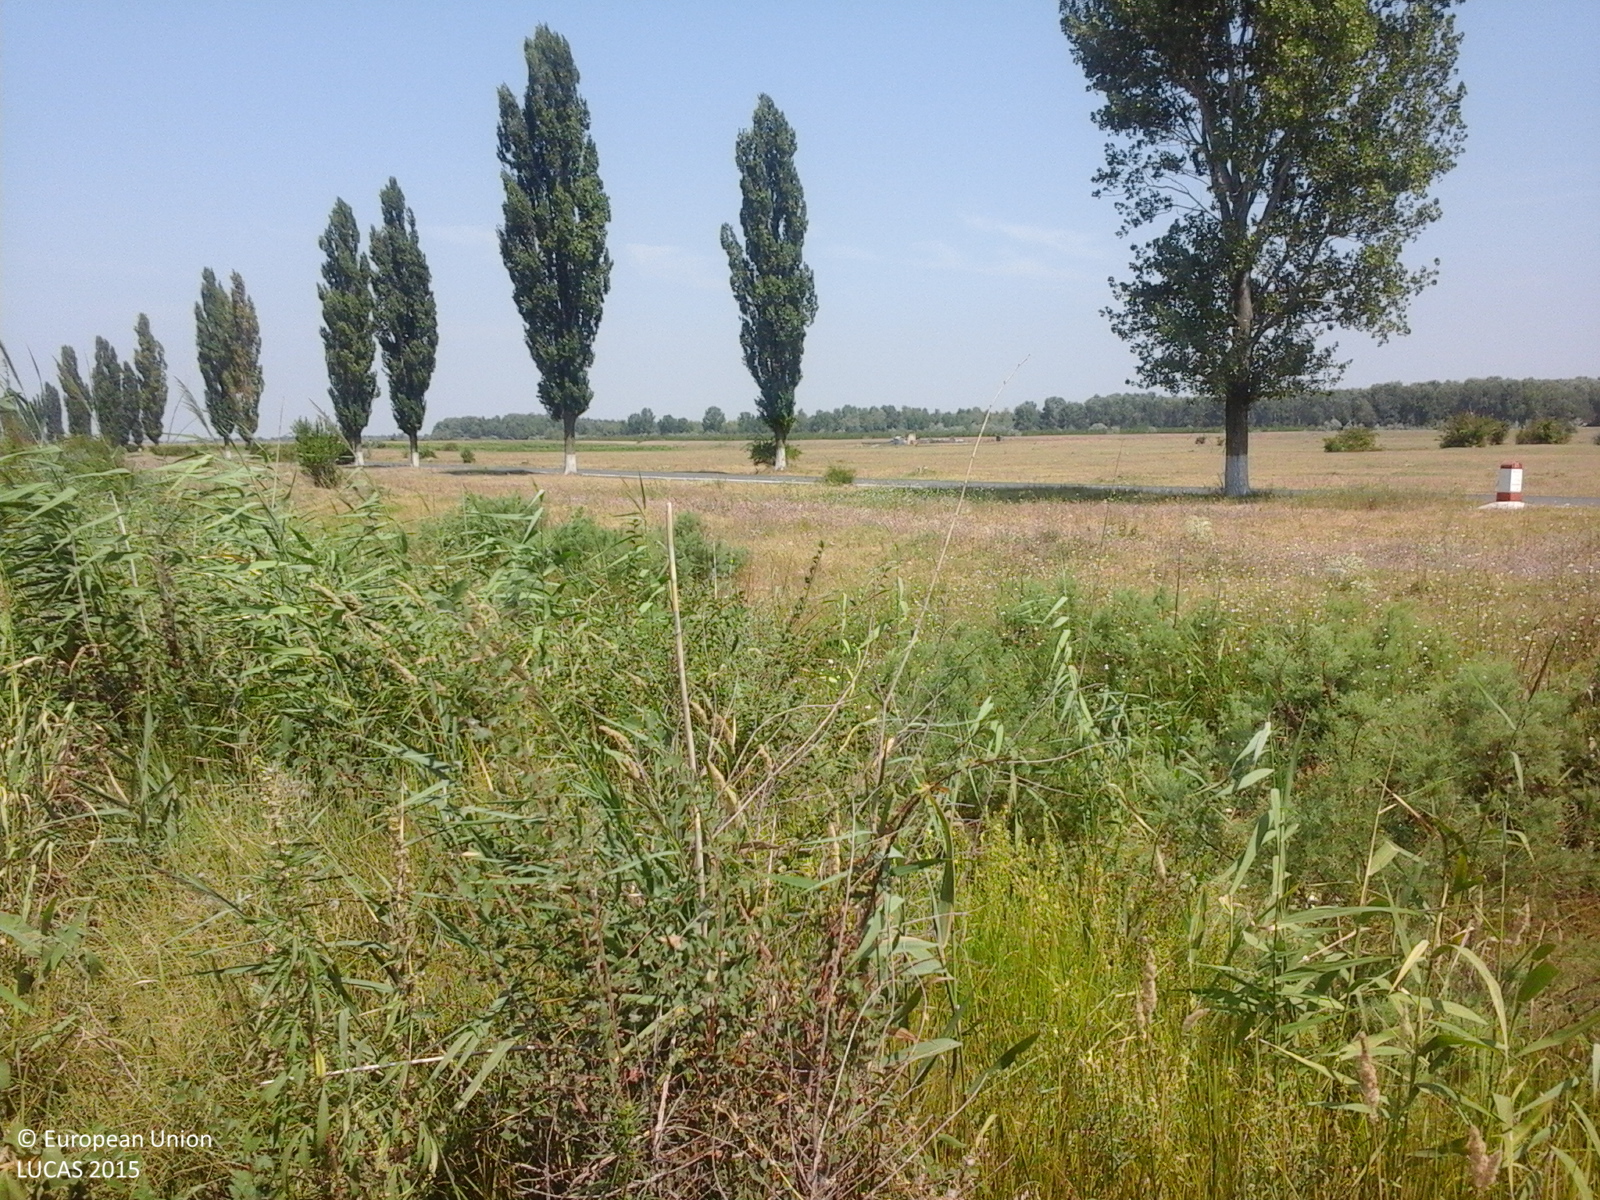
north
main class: Cropland
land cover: Maize
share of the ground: > 75 %
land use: Agriculture (excluding fallow land and kitchen gardens)
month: August
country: RO
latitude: 45.2406
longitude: 27.4100
